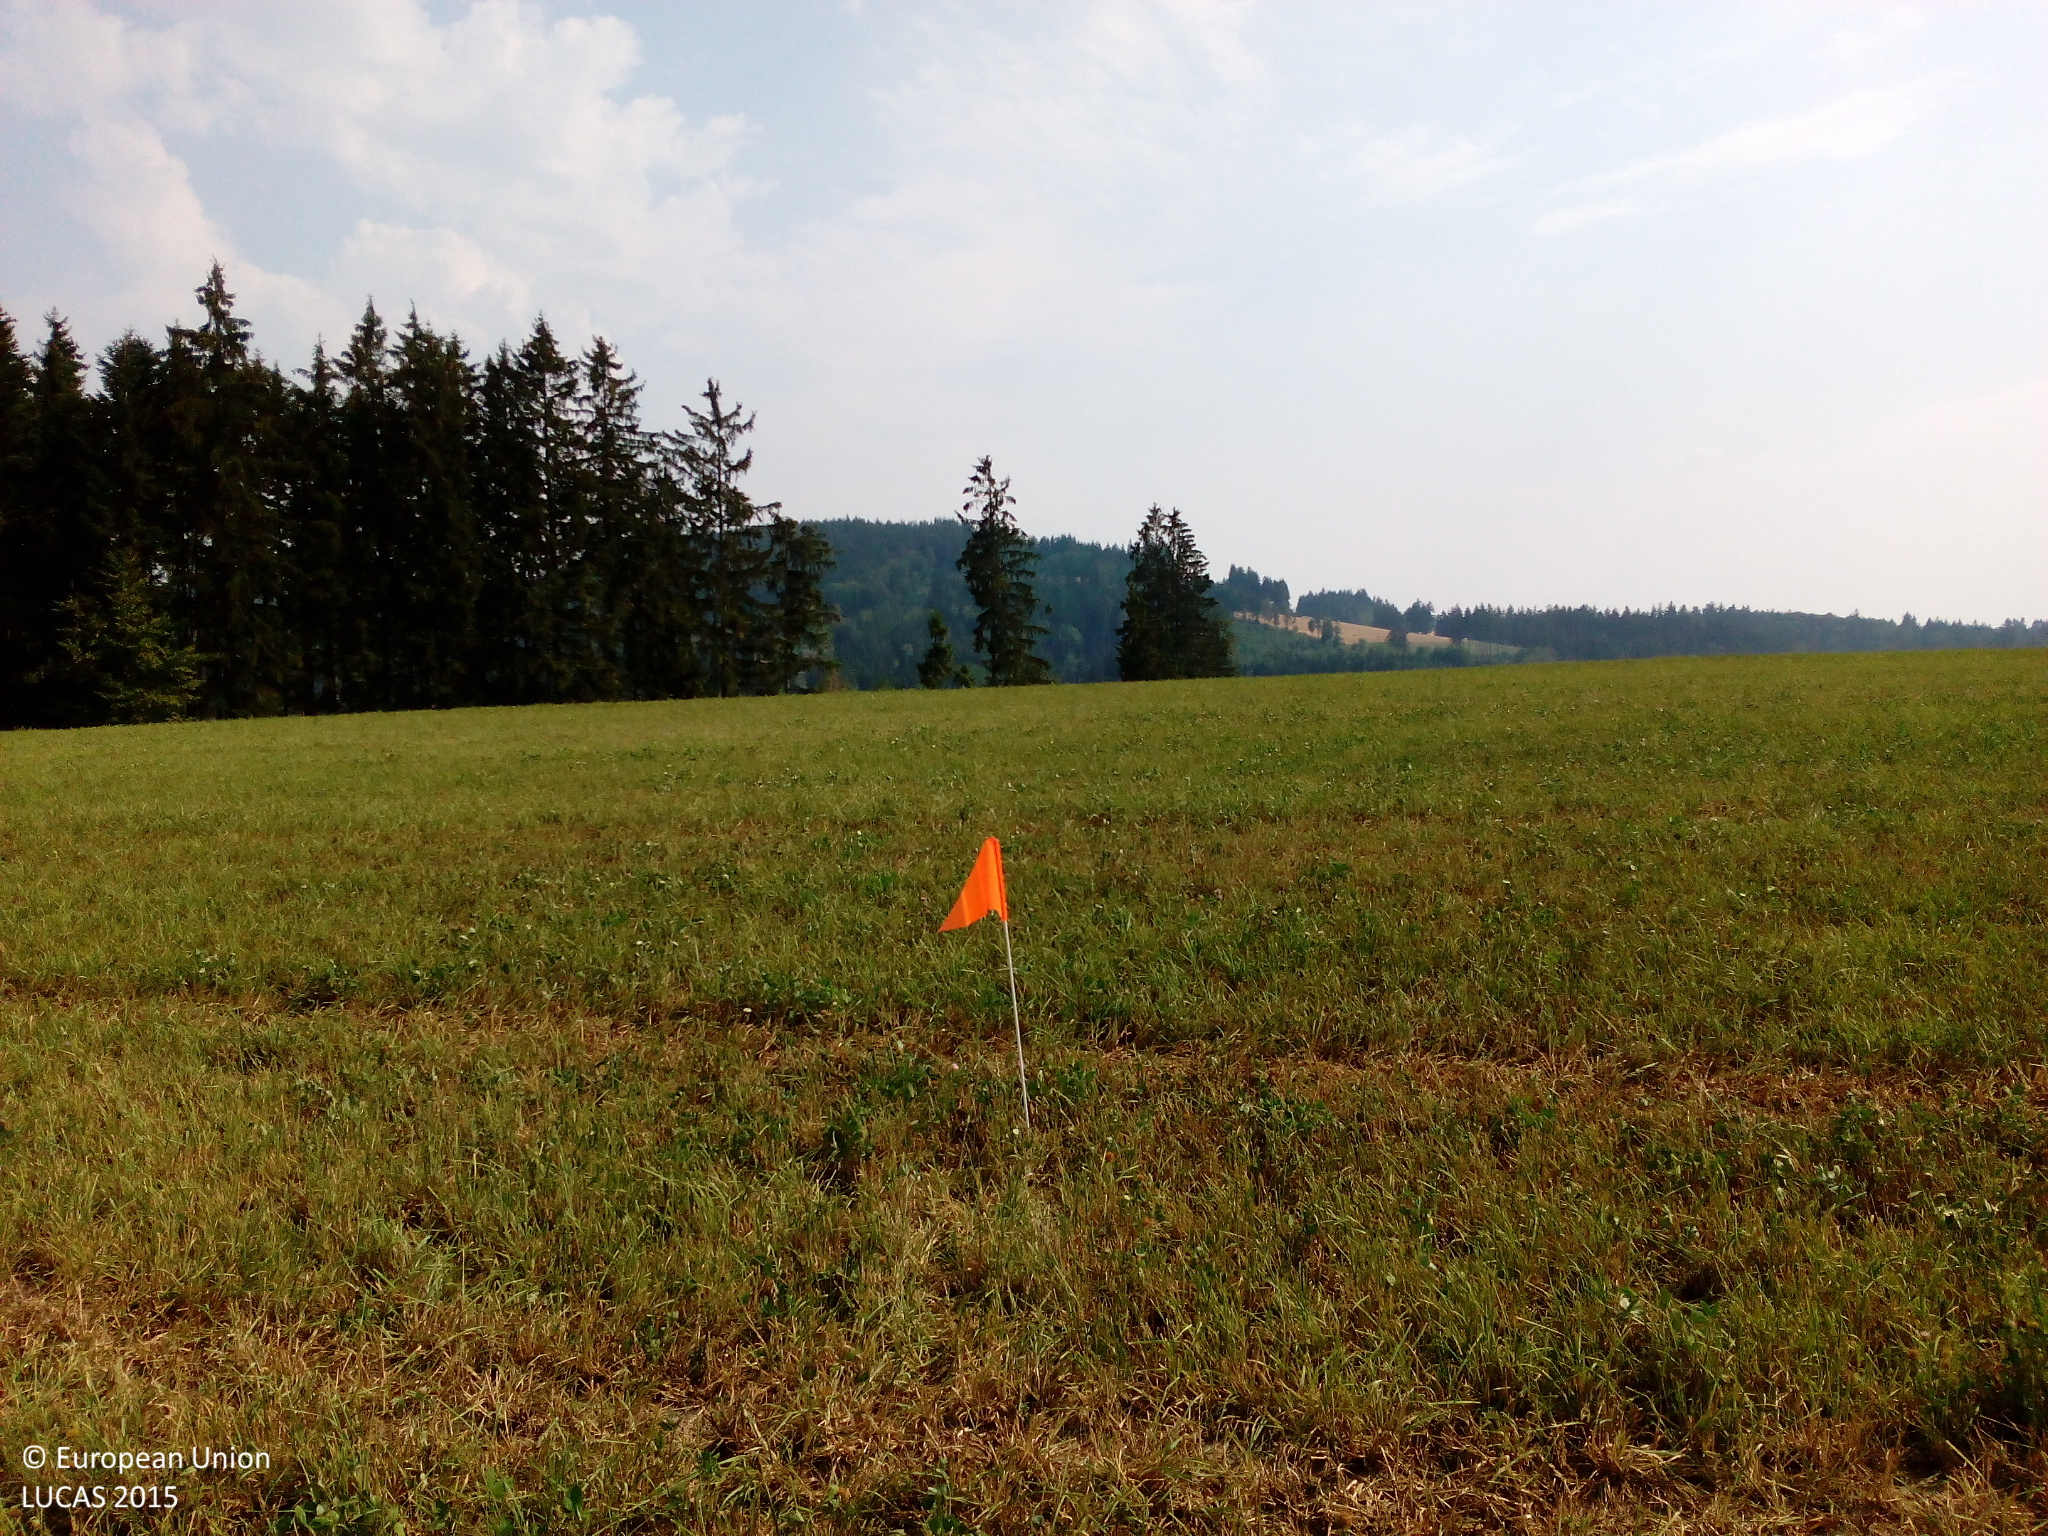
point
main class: Cropland
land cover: Temporary grasslands
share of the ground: 50 - 75 %
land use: Agriculture (excluding fallow land and kitchen gardens)
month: August
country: DE
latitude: 50.2632
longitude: 11.5848
